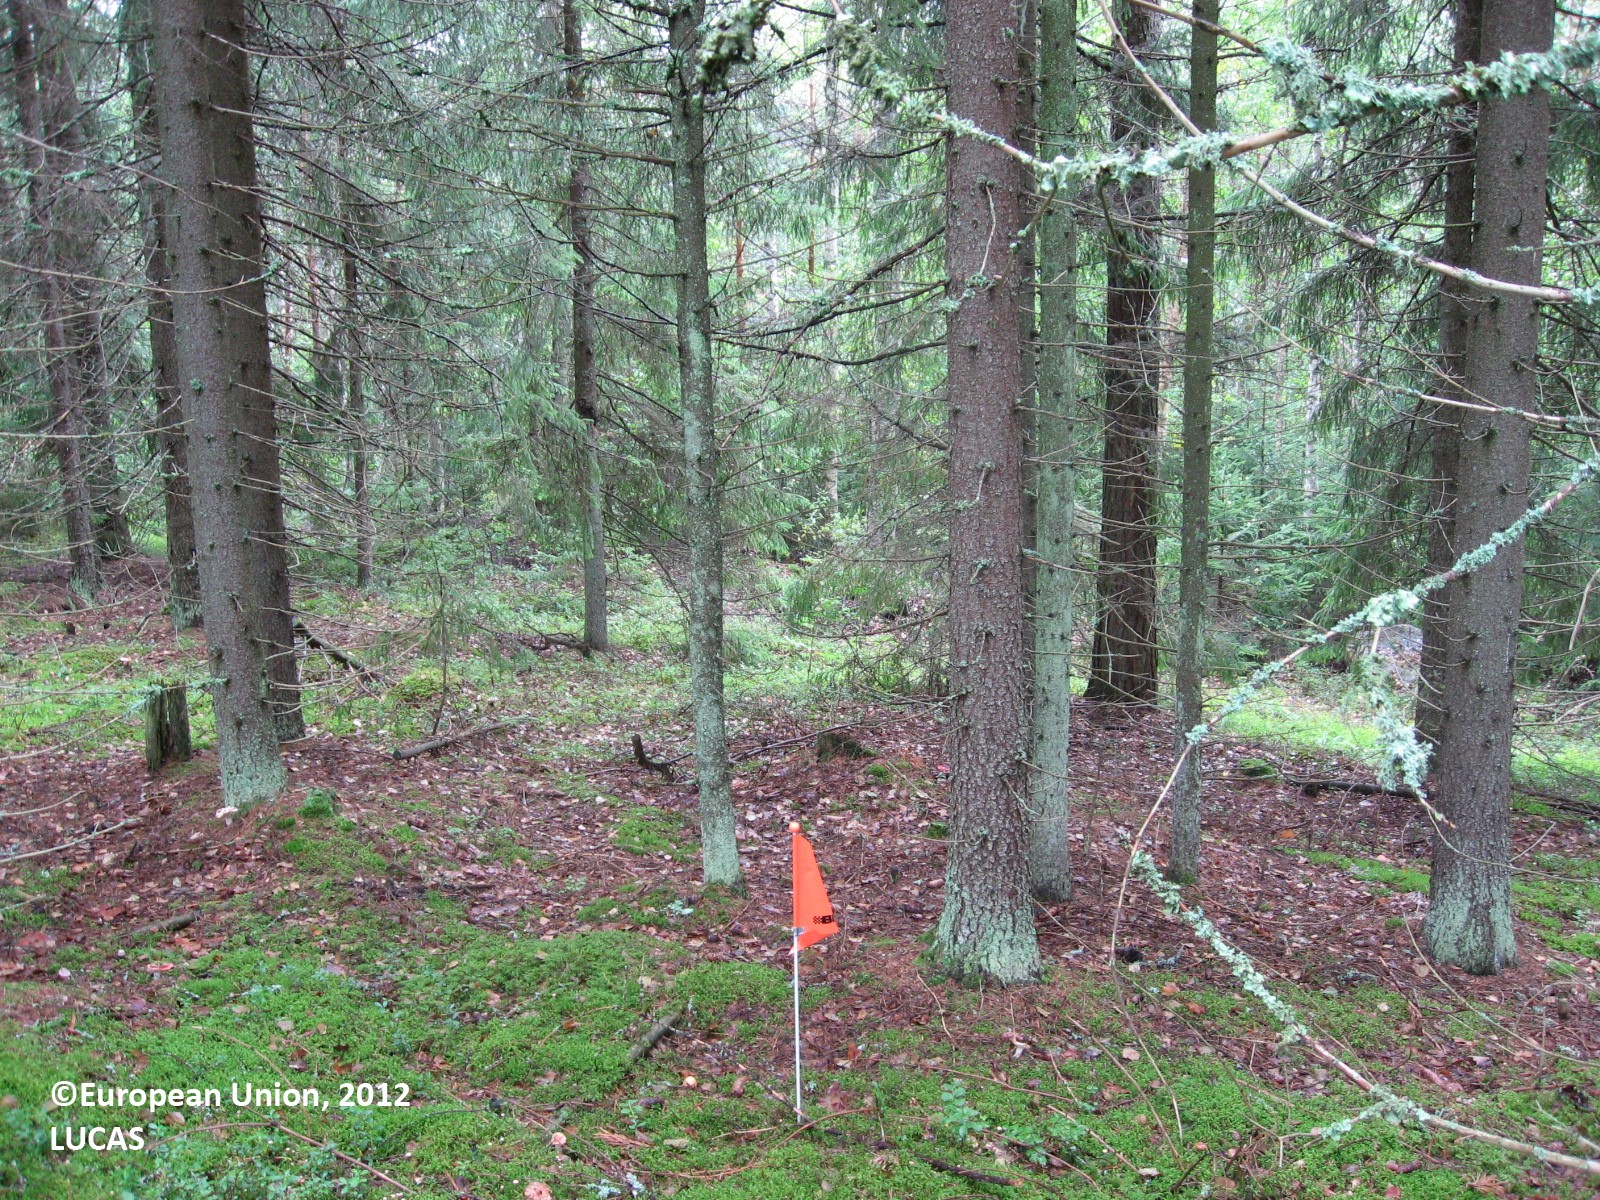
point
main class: Woodland
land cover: Spruce dominated coniferous woodland
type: boreal forest
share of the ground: > 75 %
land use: Forestry
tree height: > 5 m
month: August
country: FI
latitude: 60.6694
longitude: 25.0697
